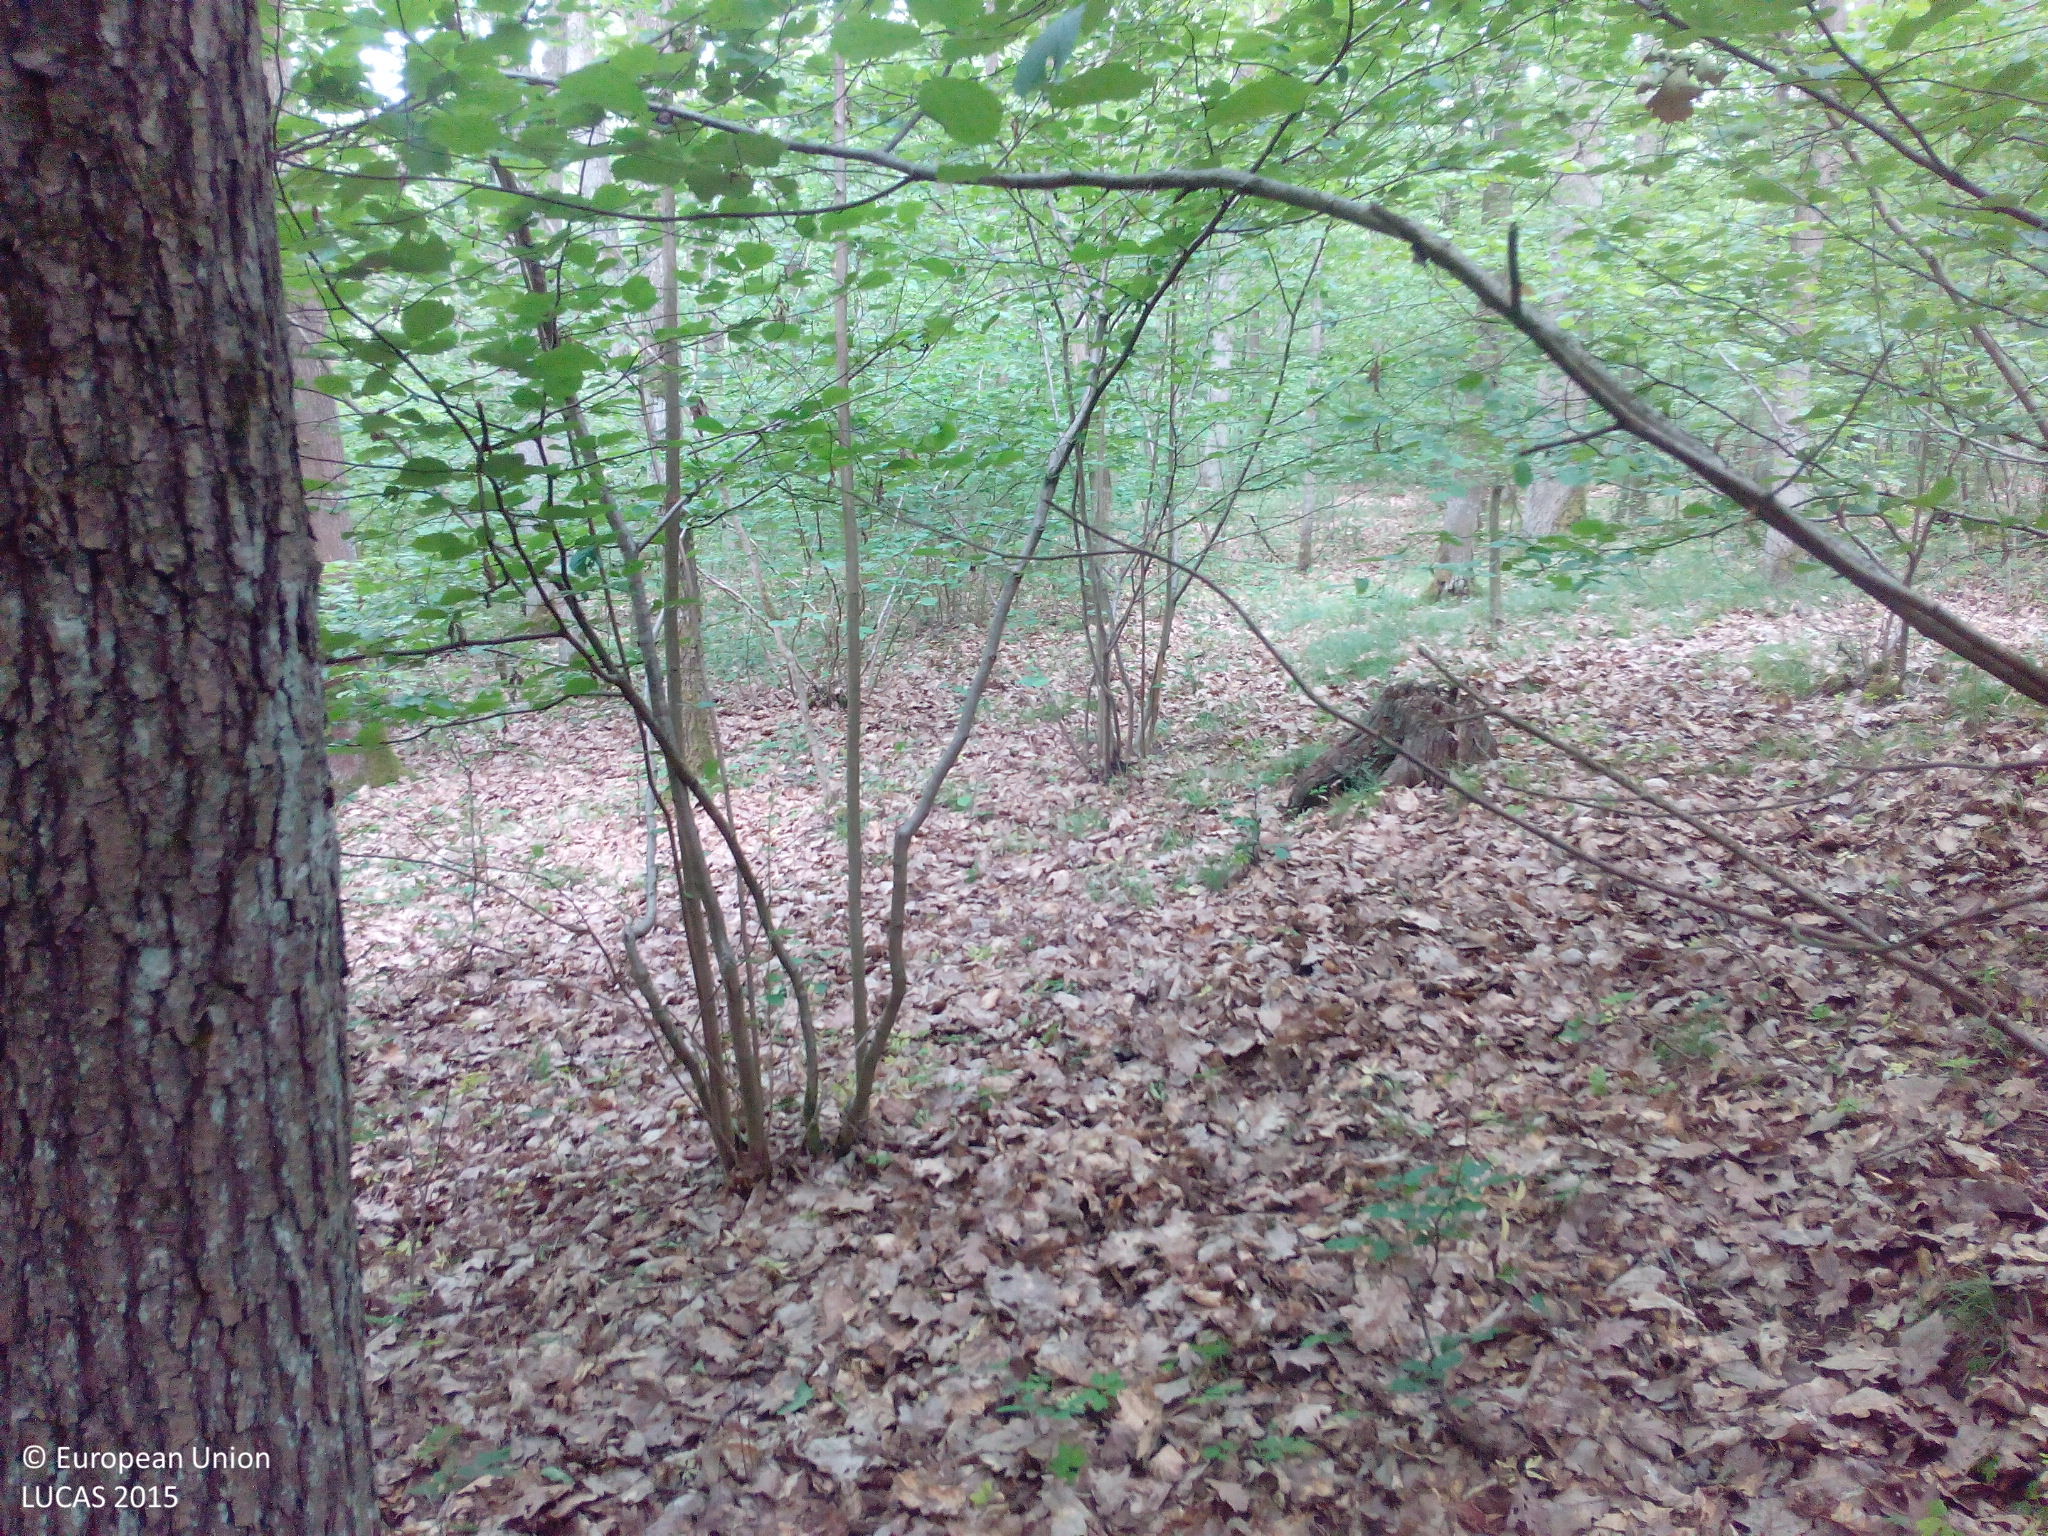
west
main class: Woodland
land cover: Broadleaved woodland
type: mesophytic deciduous forest
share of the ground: > 75 %
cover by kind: broadleaved forest trees 100 %
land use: Forestry
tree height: > 5 m
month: June
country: DE
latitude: 50.2379
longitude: 10.2663
